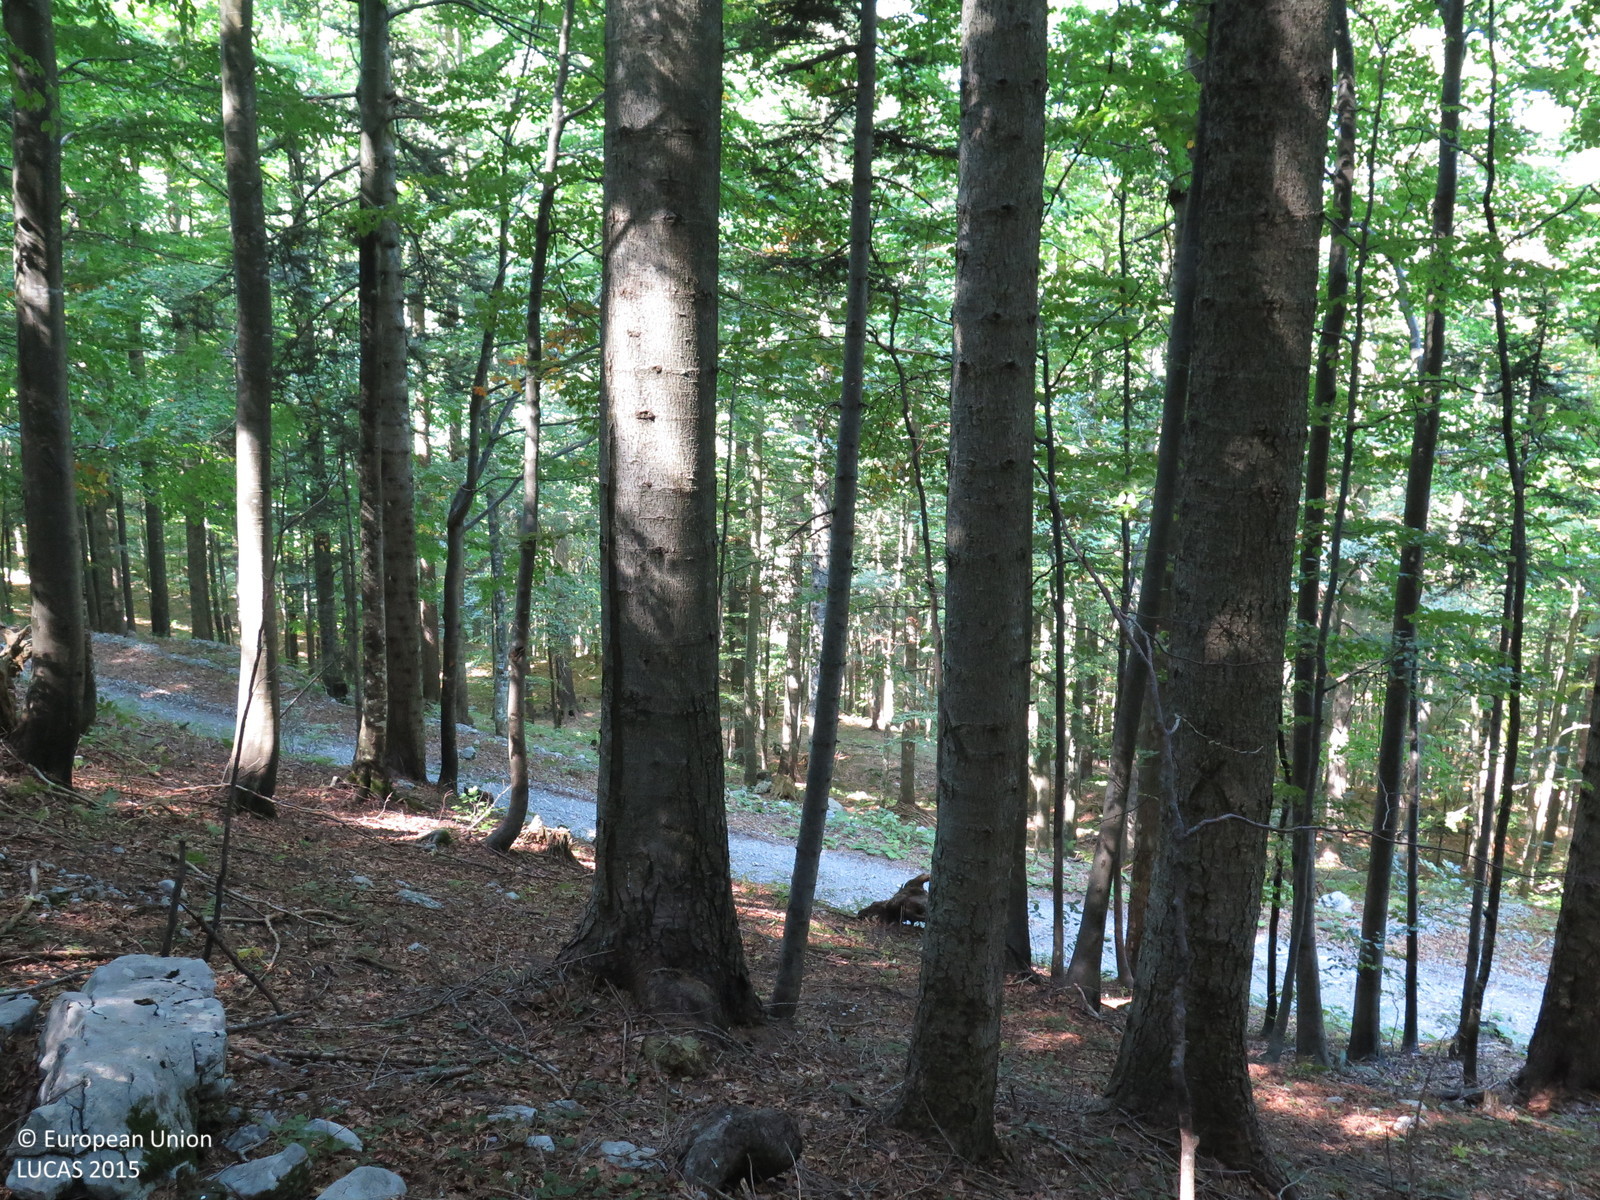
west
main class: Woodland
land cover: Other mixed woodland
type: mountainous beech forest
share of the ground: > 75 %
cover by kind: broadleaved forest trees 75 %, coniferous forest trees 25 %
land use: Forestry
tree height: > 5 m
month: September
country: HR
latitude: 45.5352
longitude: 14.4902
